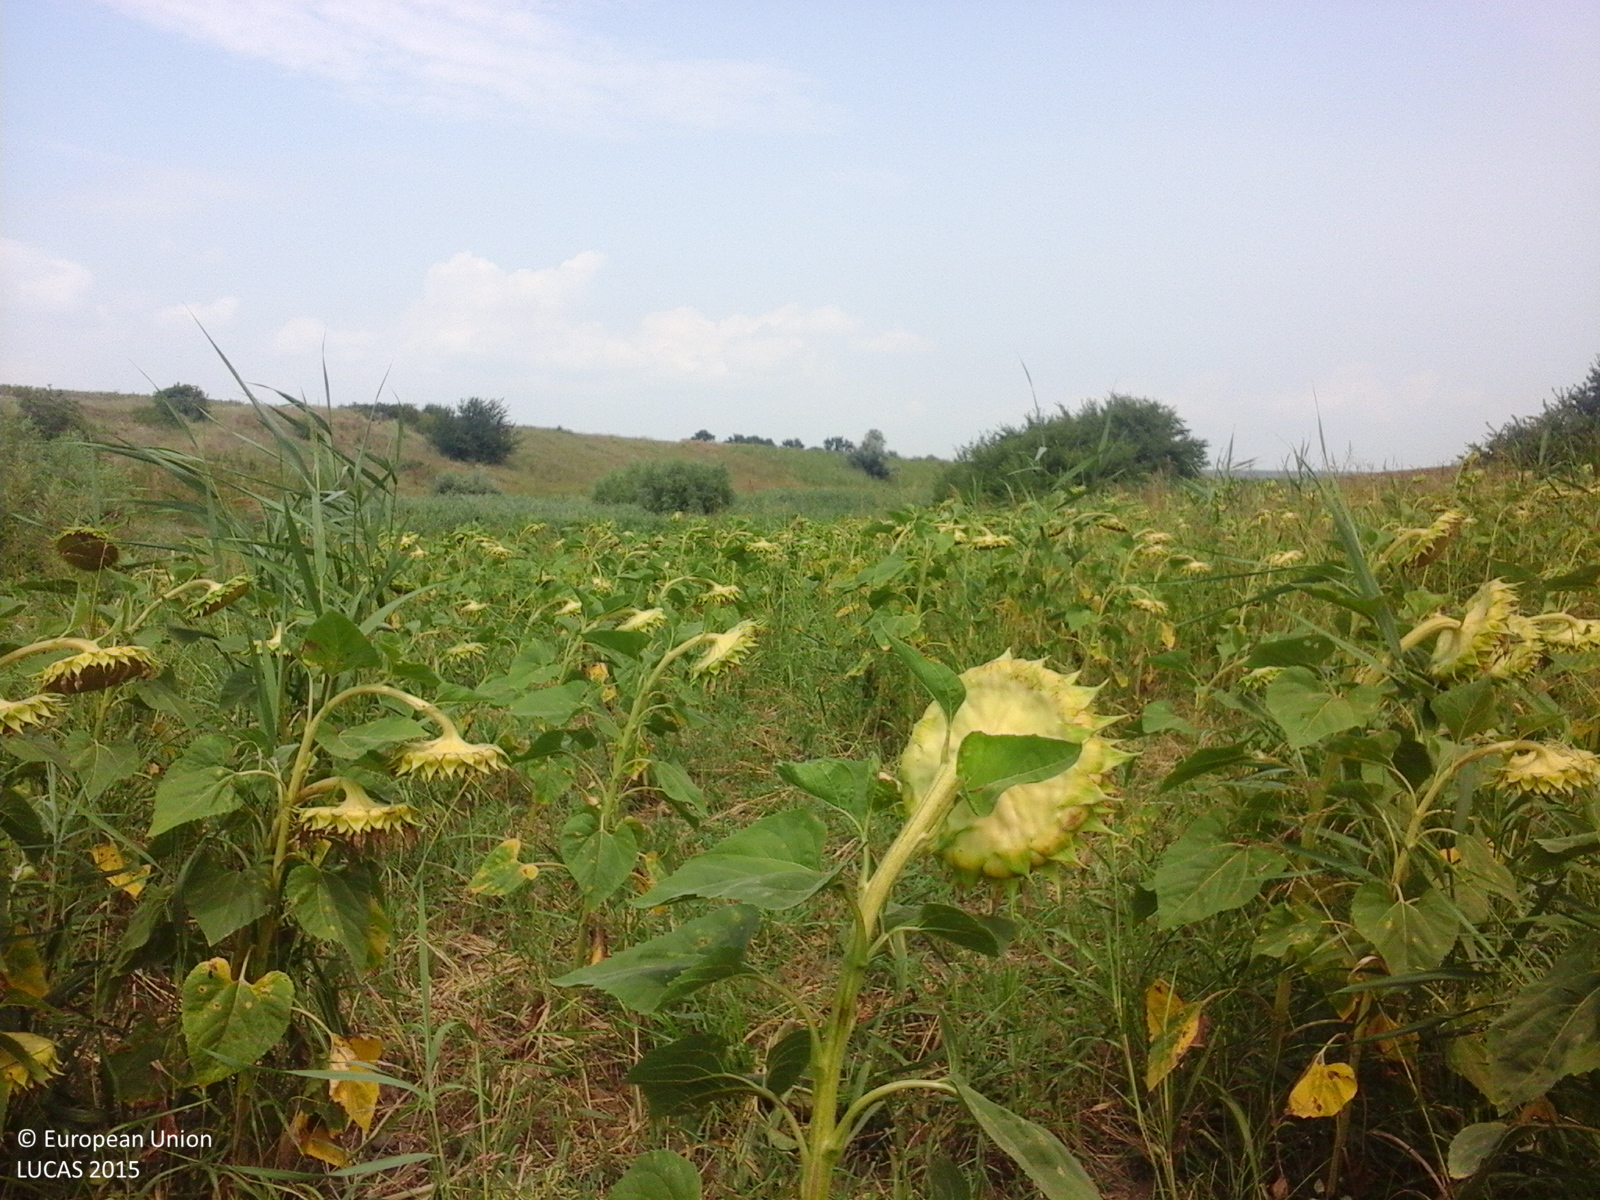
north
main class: Cropland
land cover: Sunflower
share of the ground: > 75 %
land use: Agriculture (excluding fallow land and kitchen gardens)
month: July
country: RO
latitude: 45.2119
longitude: 28.5311
